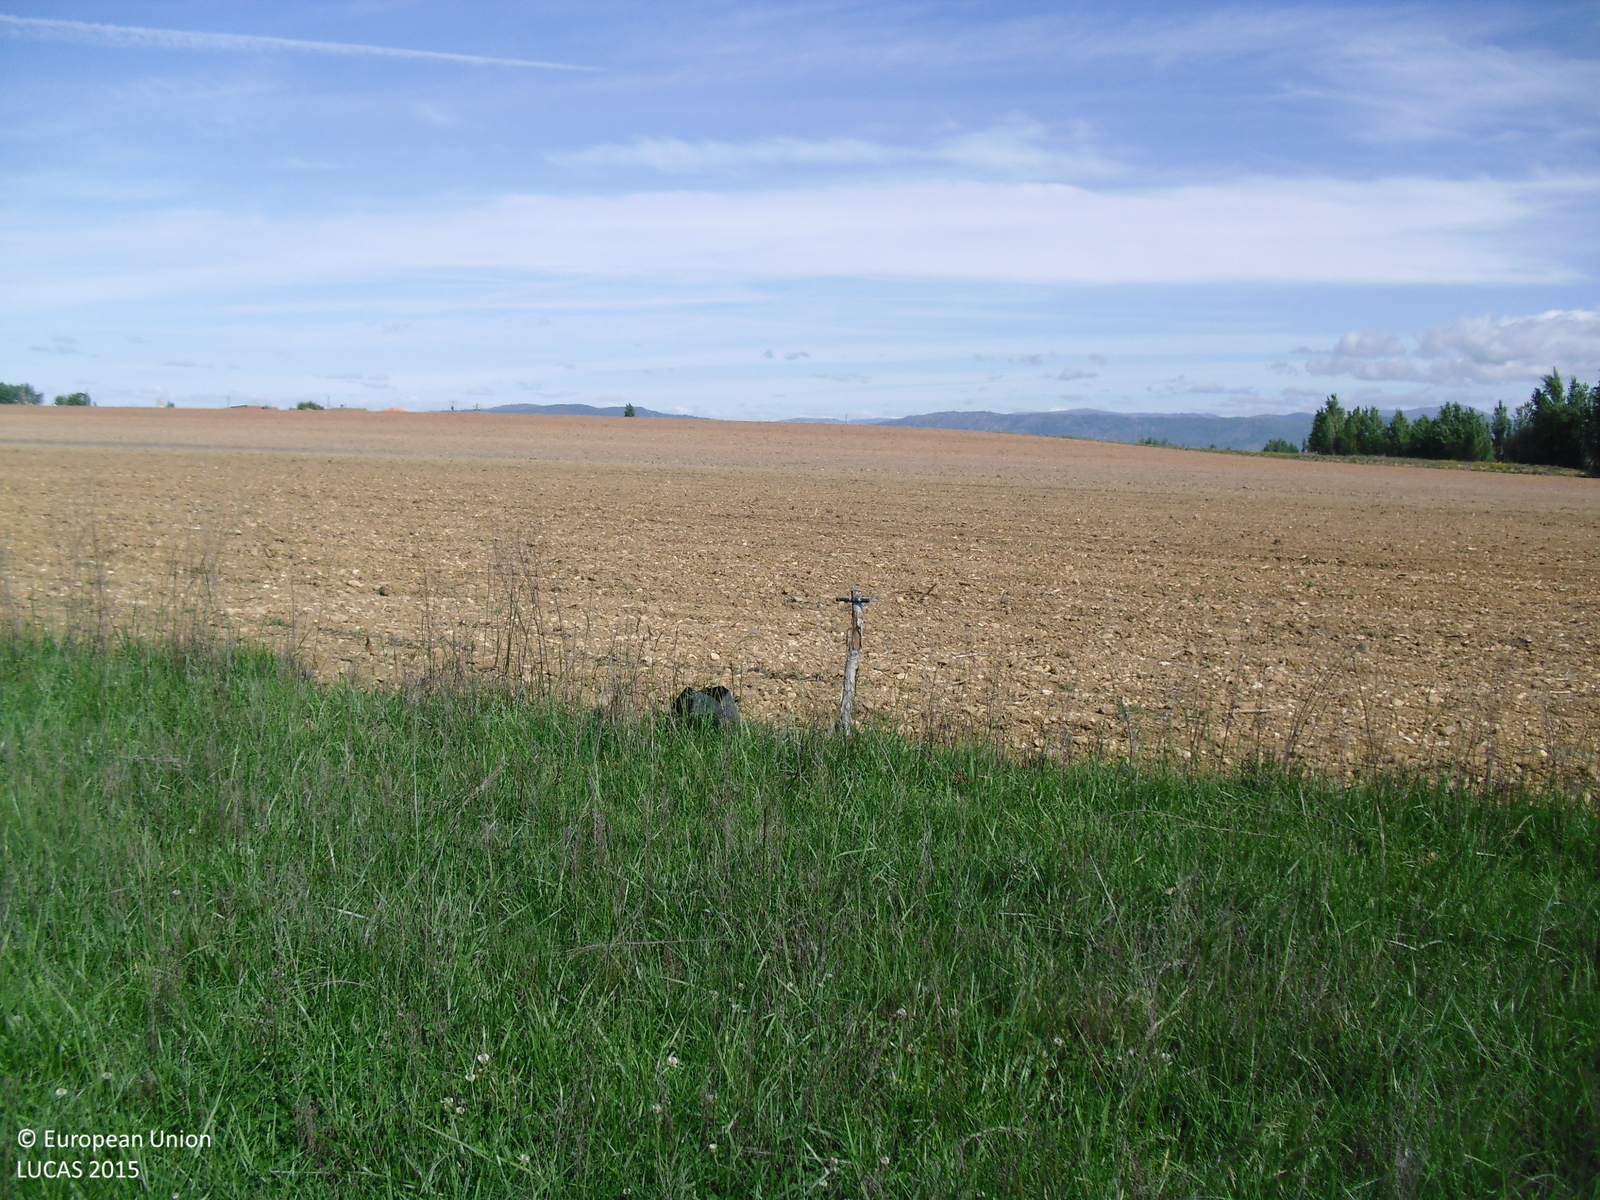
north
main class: Cropland
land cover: Temporary grasslands
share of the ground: > 75 %
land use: Agriculture (excluding fallow land and kitchen gardens)
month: April
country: ES
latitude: 40.0165
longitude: -6.7333
